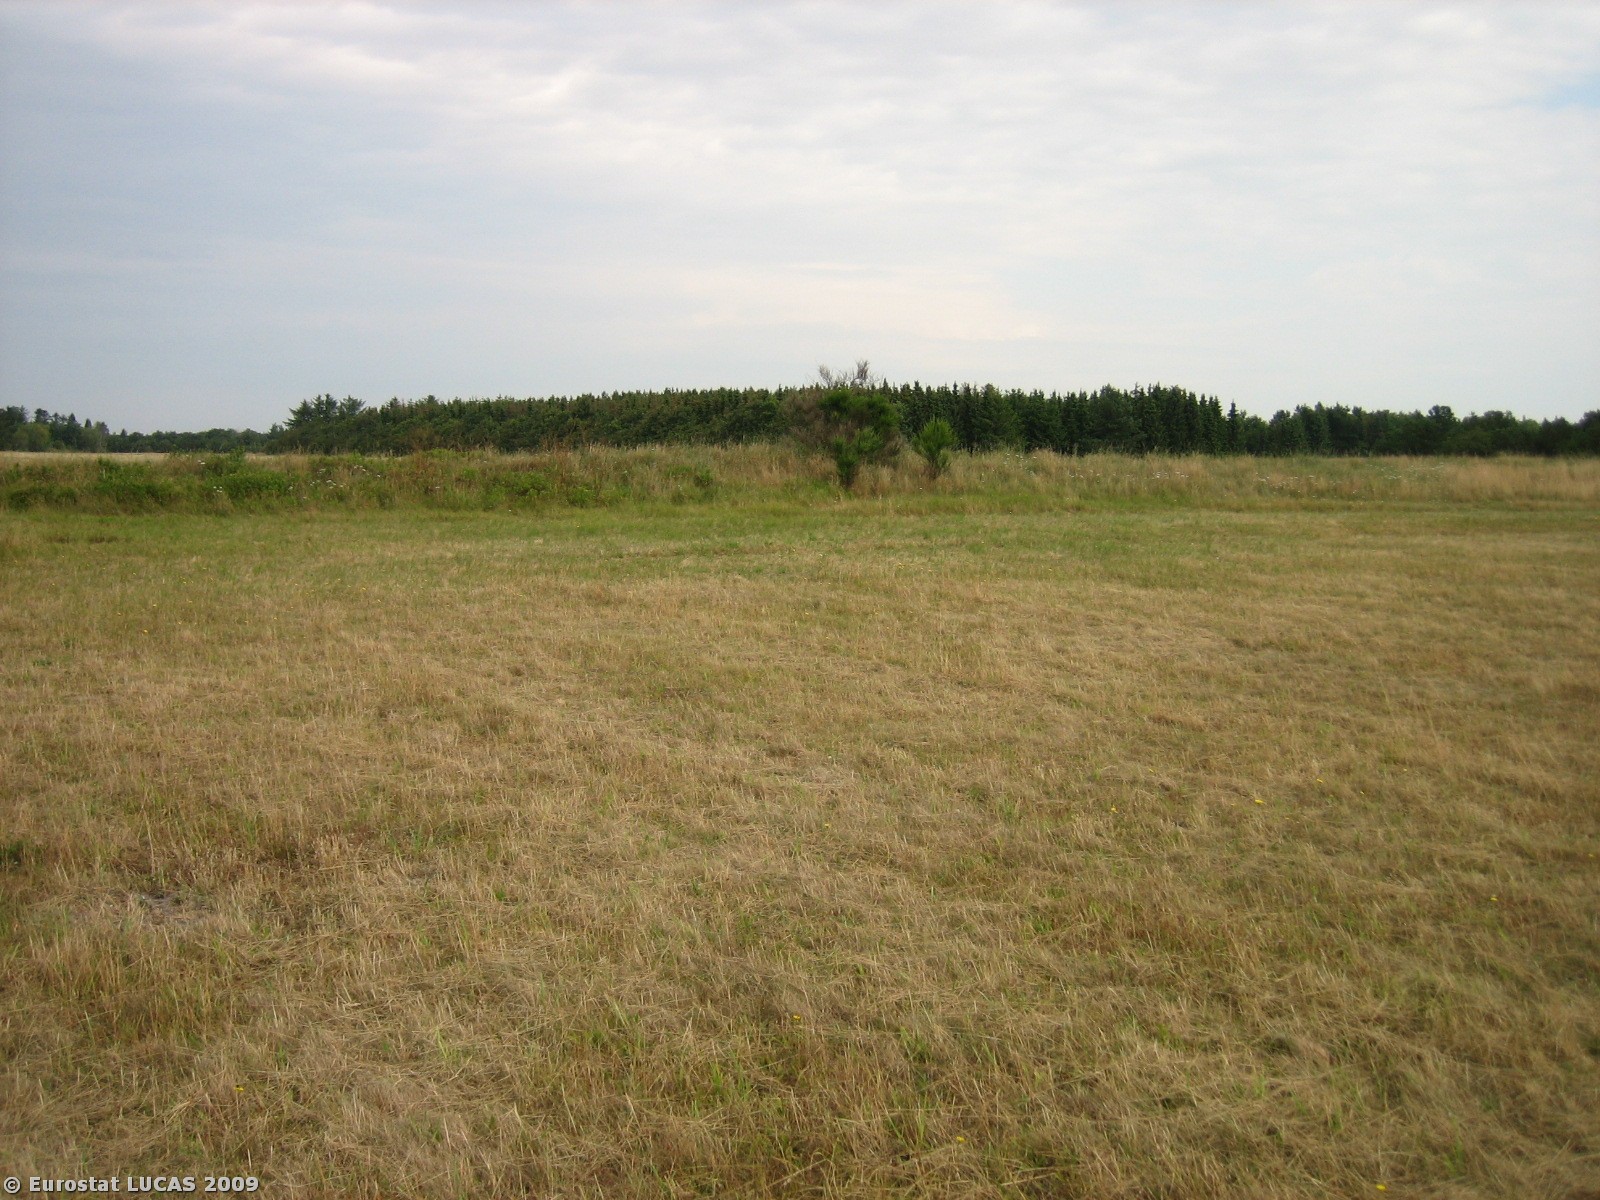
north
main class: Grassland
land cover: Grassland without tree/shrub cover
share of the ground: > 75 %
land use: Agriculture (excluding fallow land and kitchen gardens)
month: July
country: DK
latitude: 55.8724
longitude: 8.4194
